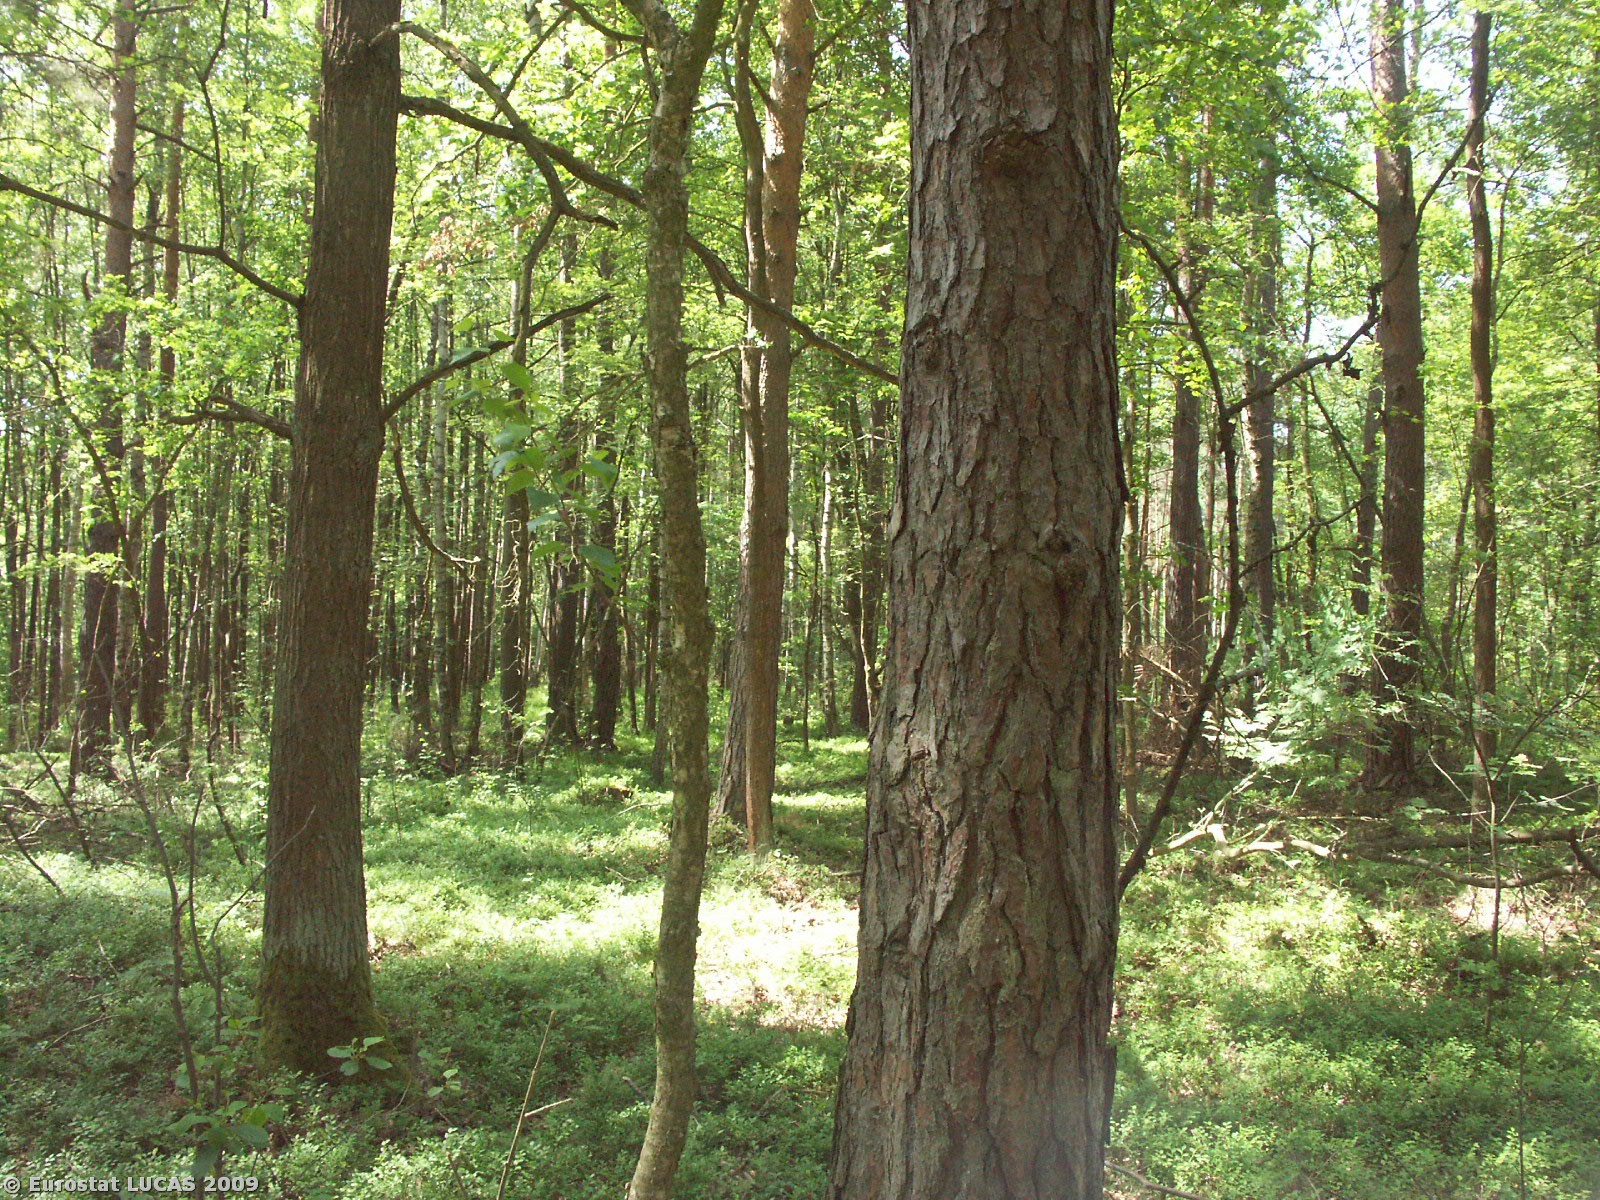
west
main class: Woodland
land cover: Mixed woodland
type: hemiboreal forest and nemoral coniferous forest and mixed broadleaved-coniferous forest
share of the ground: > 75 %
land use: Forestry
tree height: > 5 m
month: May
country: CZ
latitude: 49.0259
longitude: 14.6650
